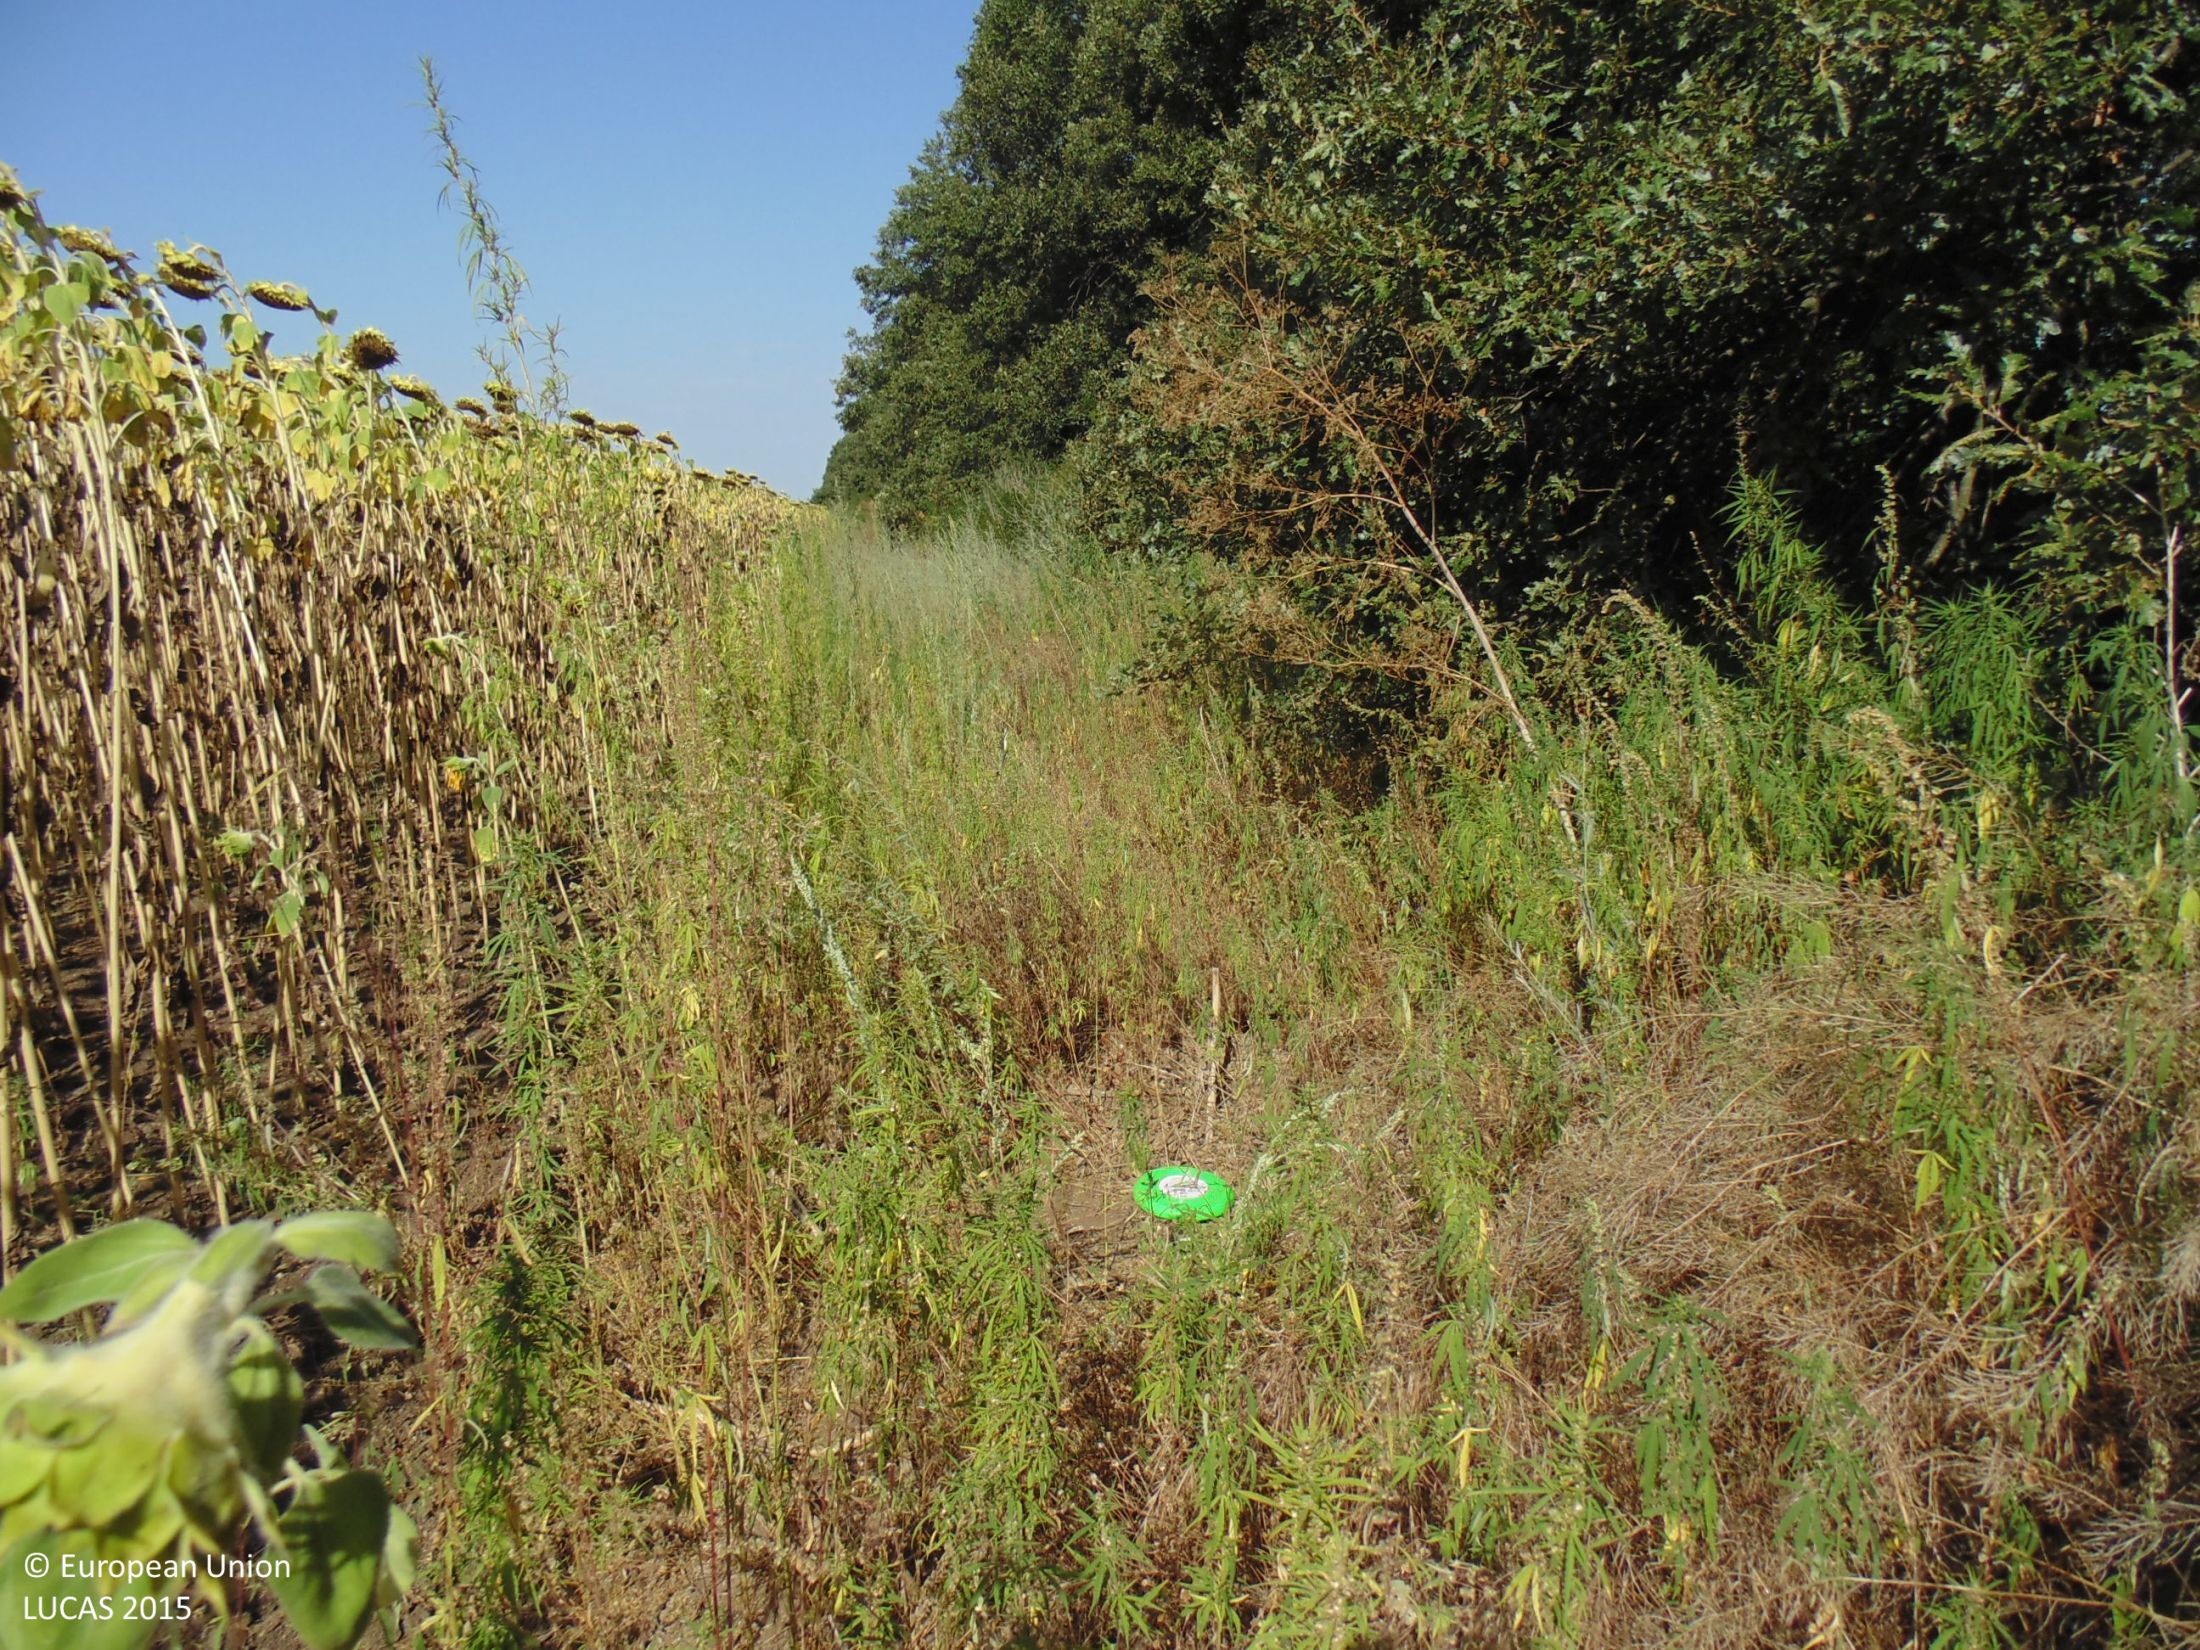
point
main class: Woodland
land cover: Broadleaved woodland
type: mesophytic deciduous forest
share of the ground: > 75 %
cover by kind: broadleaved forest trees 80 %, shrubs 10 %, herbaceous plants 10 %
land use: Forestry
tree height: > 5 m
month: August
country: BG
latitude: 43.6484
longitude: 28.1923
